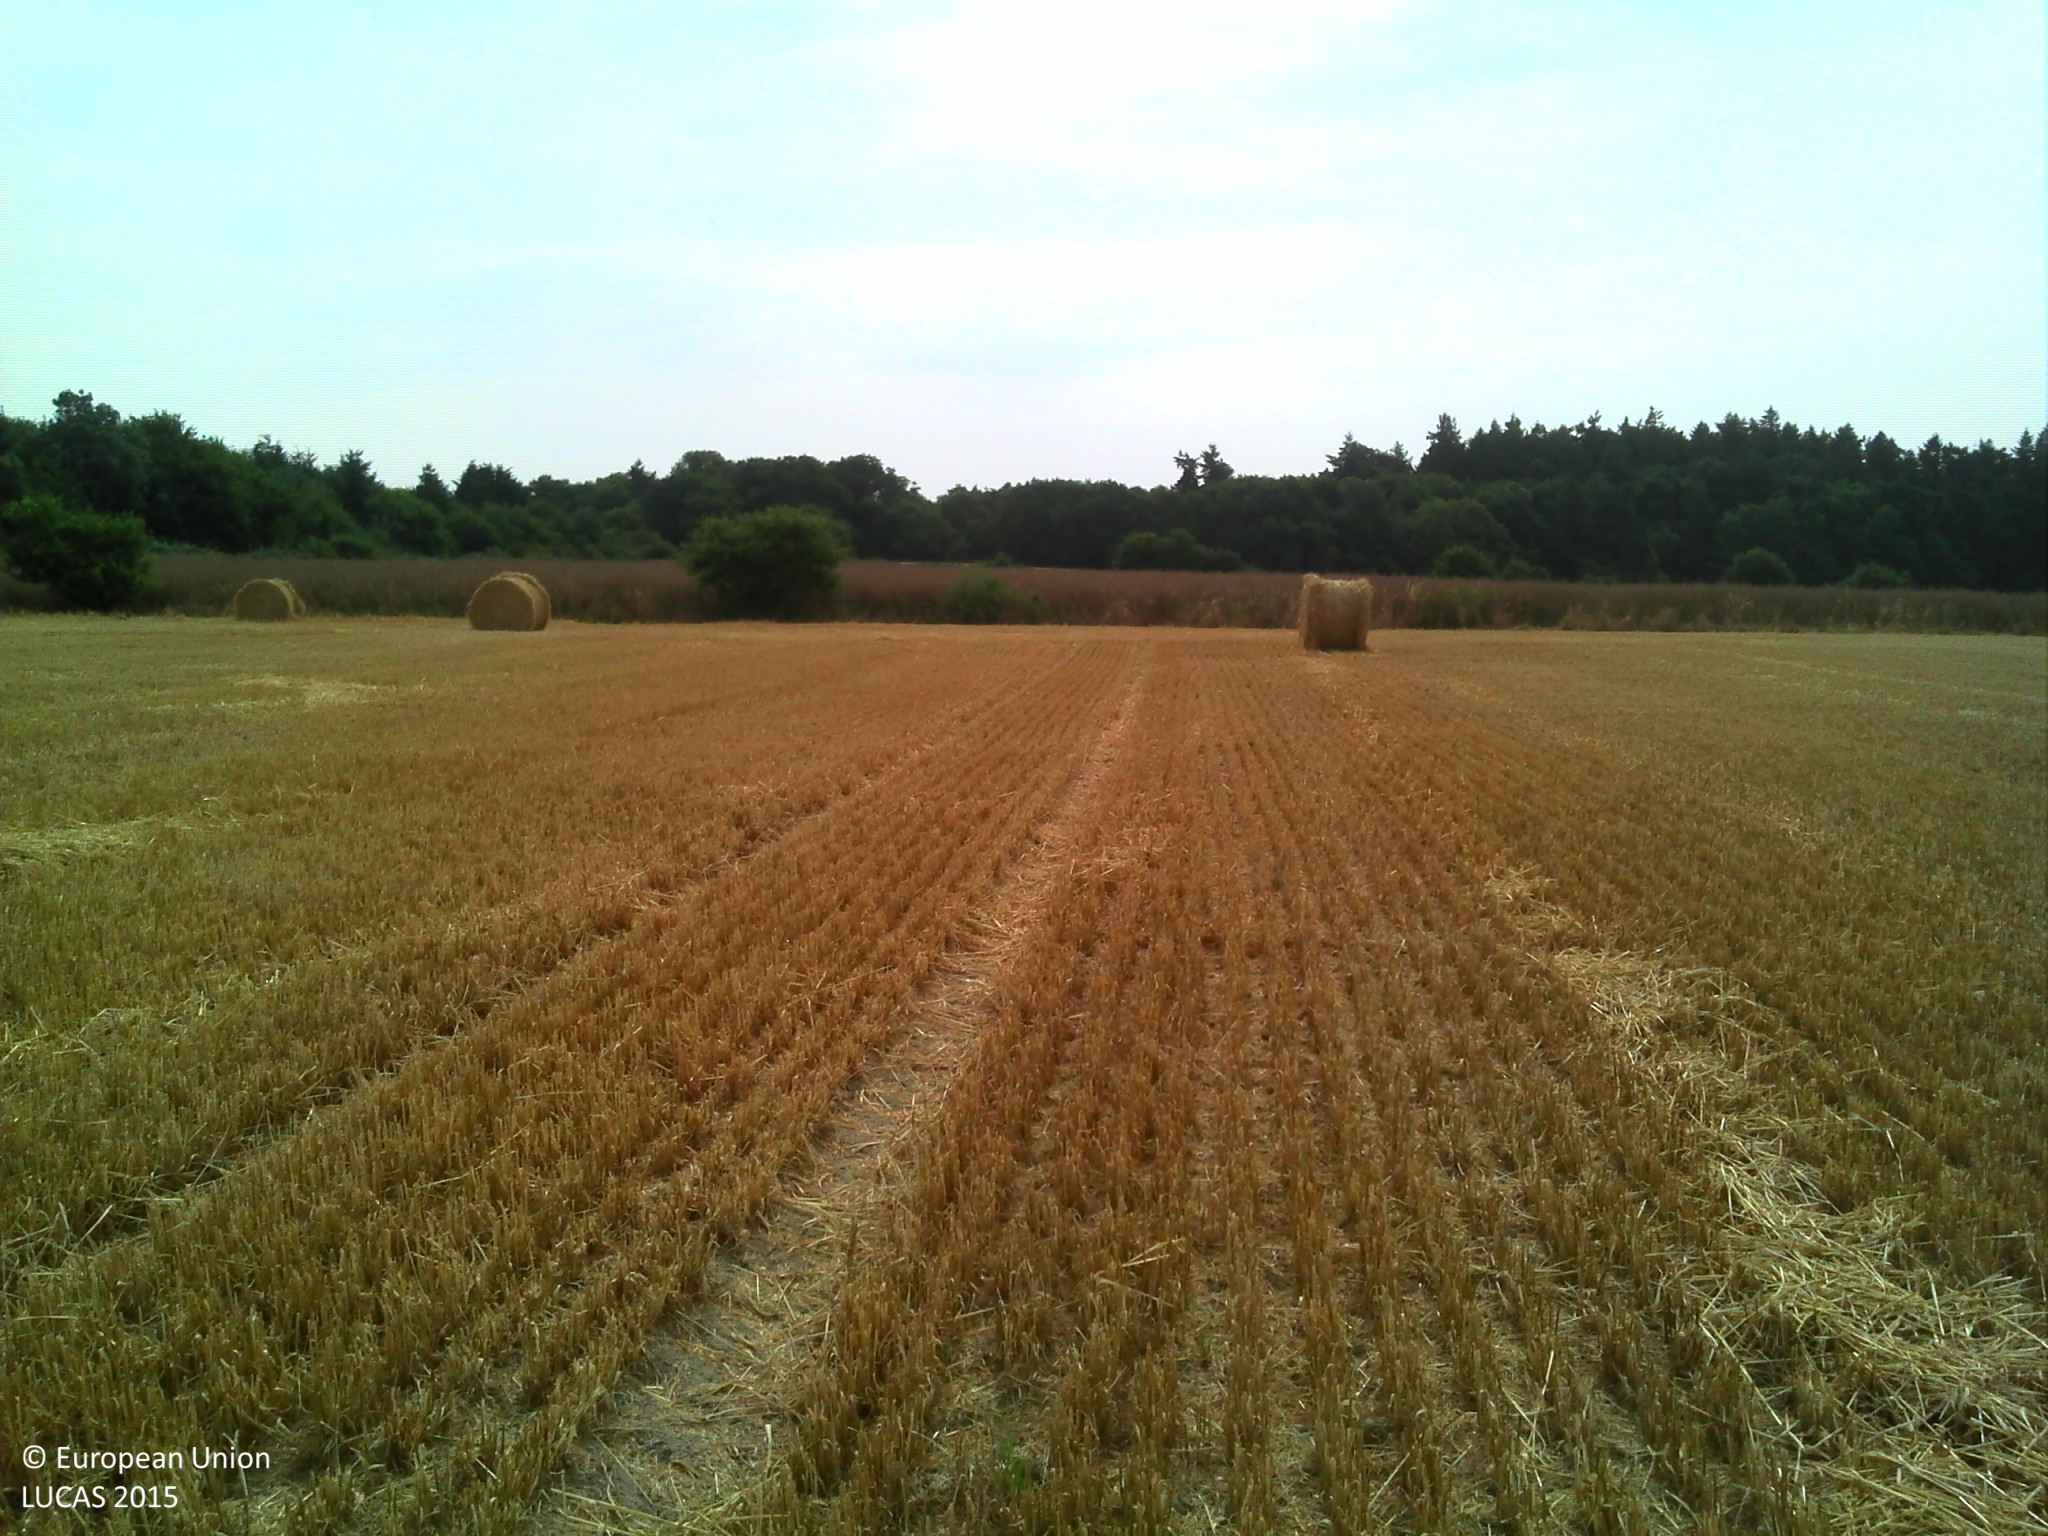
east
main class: Cropland
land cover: Barley
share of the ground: > 75 %
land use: Agriculture (excluding fallow land and kitchen gardens)
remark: Harvested field
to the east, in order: Barley; Fences; Rape and turnip rape; Fences; Abandoned hedges; Tracks; Broadleaved woodland; Other coniferous woodland; Fences; Grassland without tree/shrub cover
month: July
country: FR
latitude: 47.2961
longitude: -1.8022
